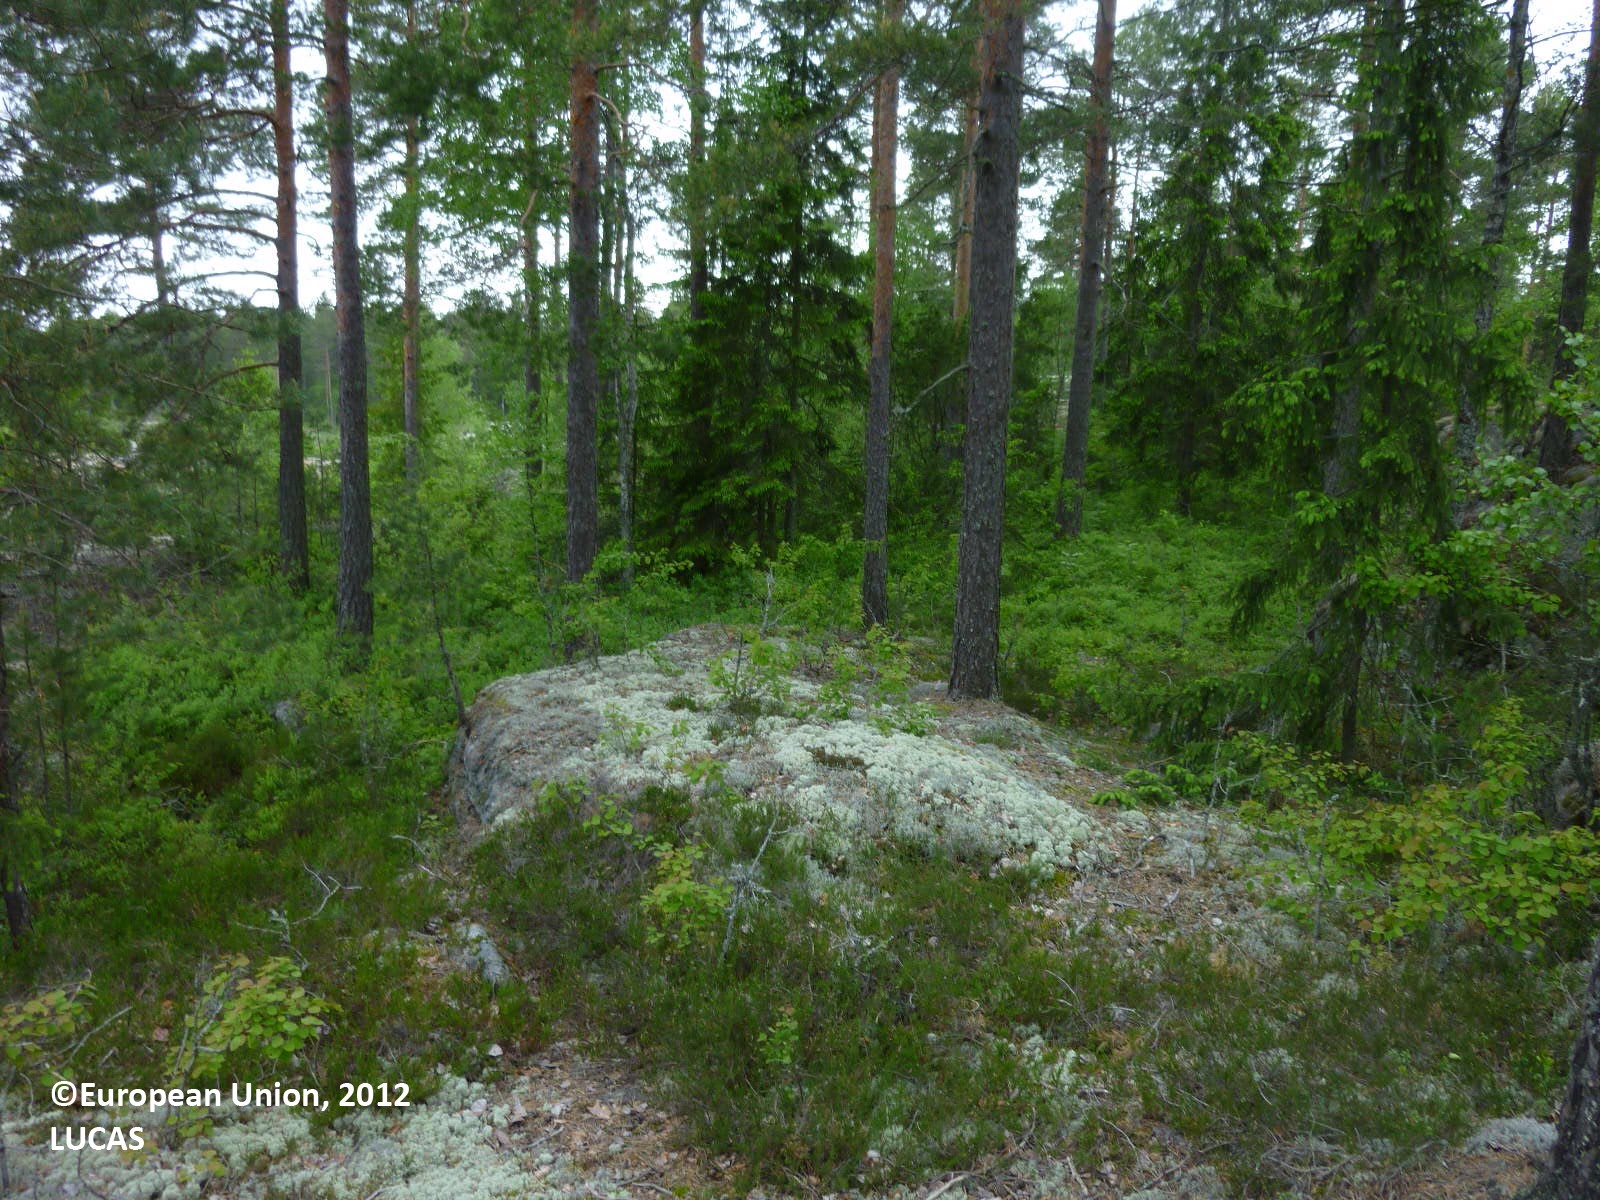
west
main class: Woodland
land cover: Pine dominated coniferous woodland
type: boreal forest
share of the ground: 25 - 50 %
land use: Forestry
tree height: > 5 m
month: June
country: FI
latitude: 60.3763
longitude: 22.6417
